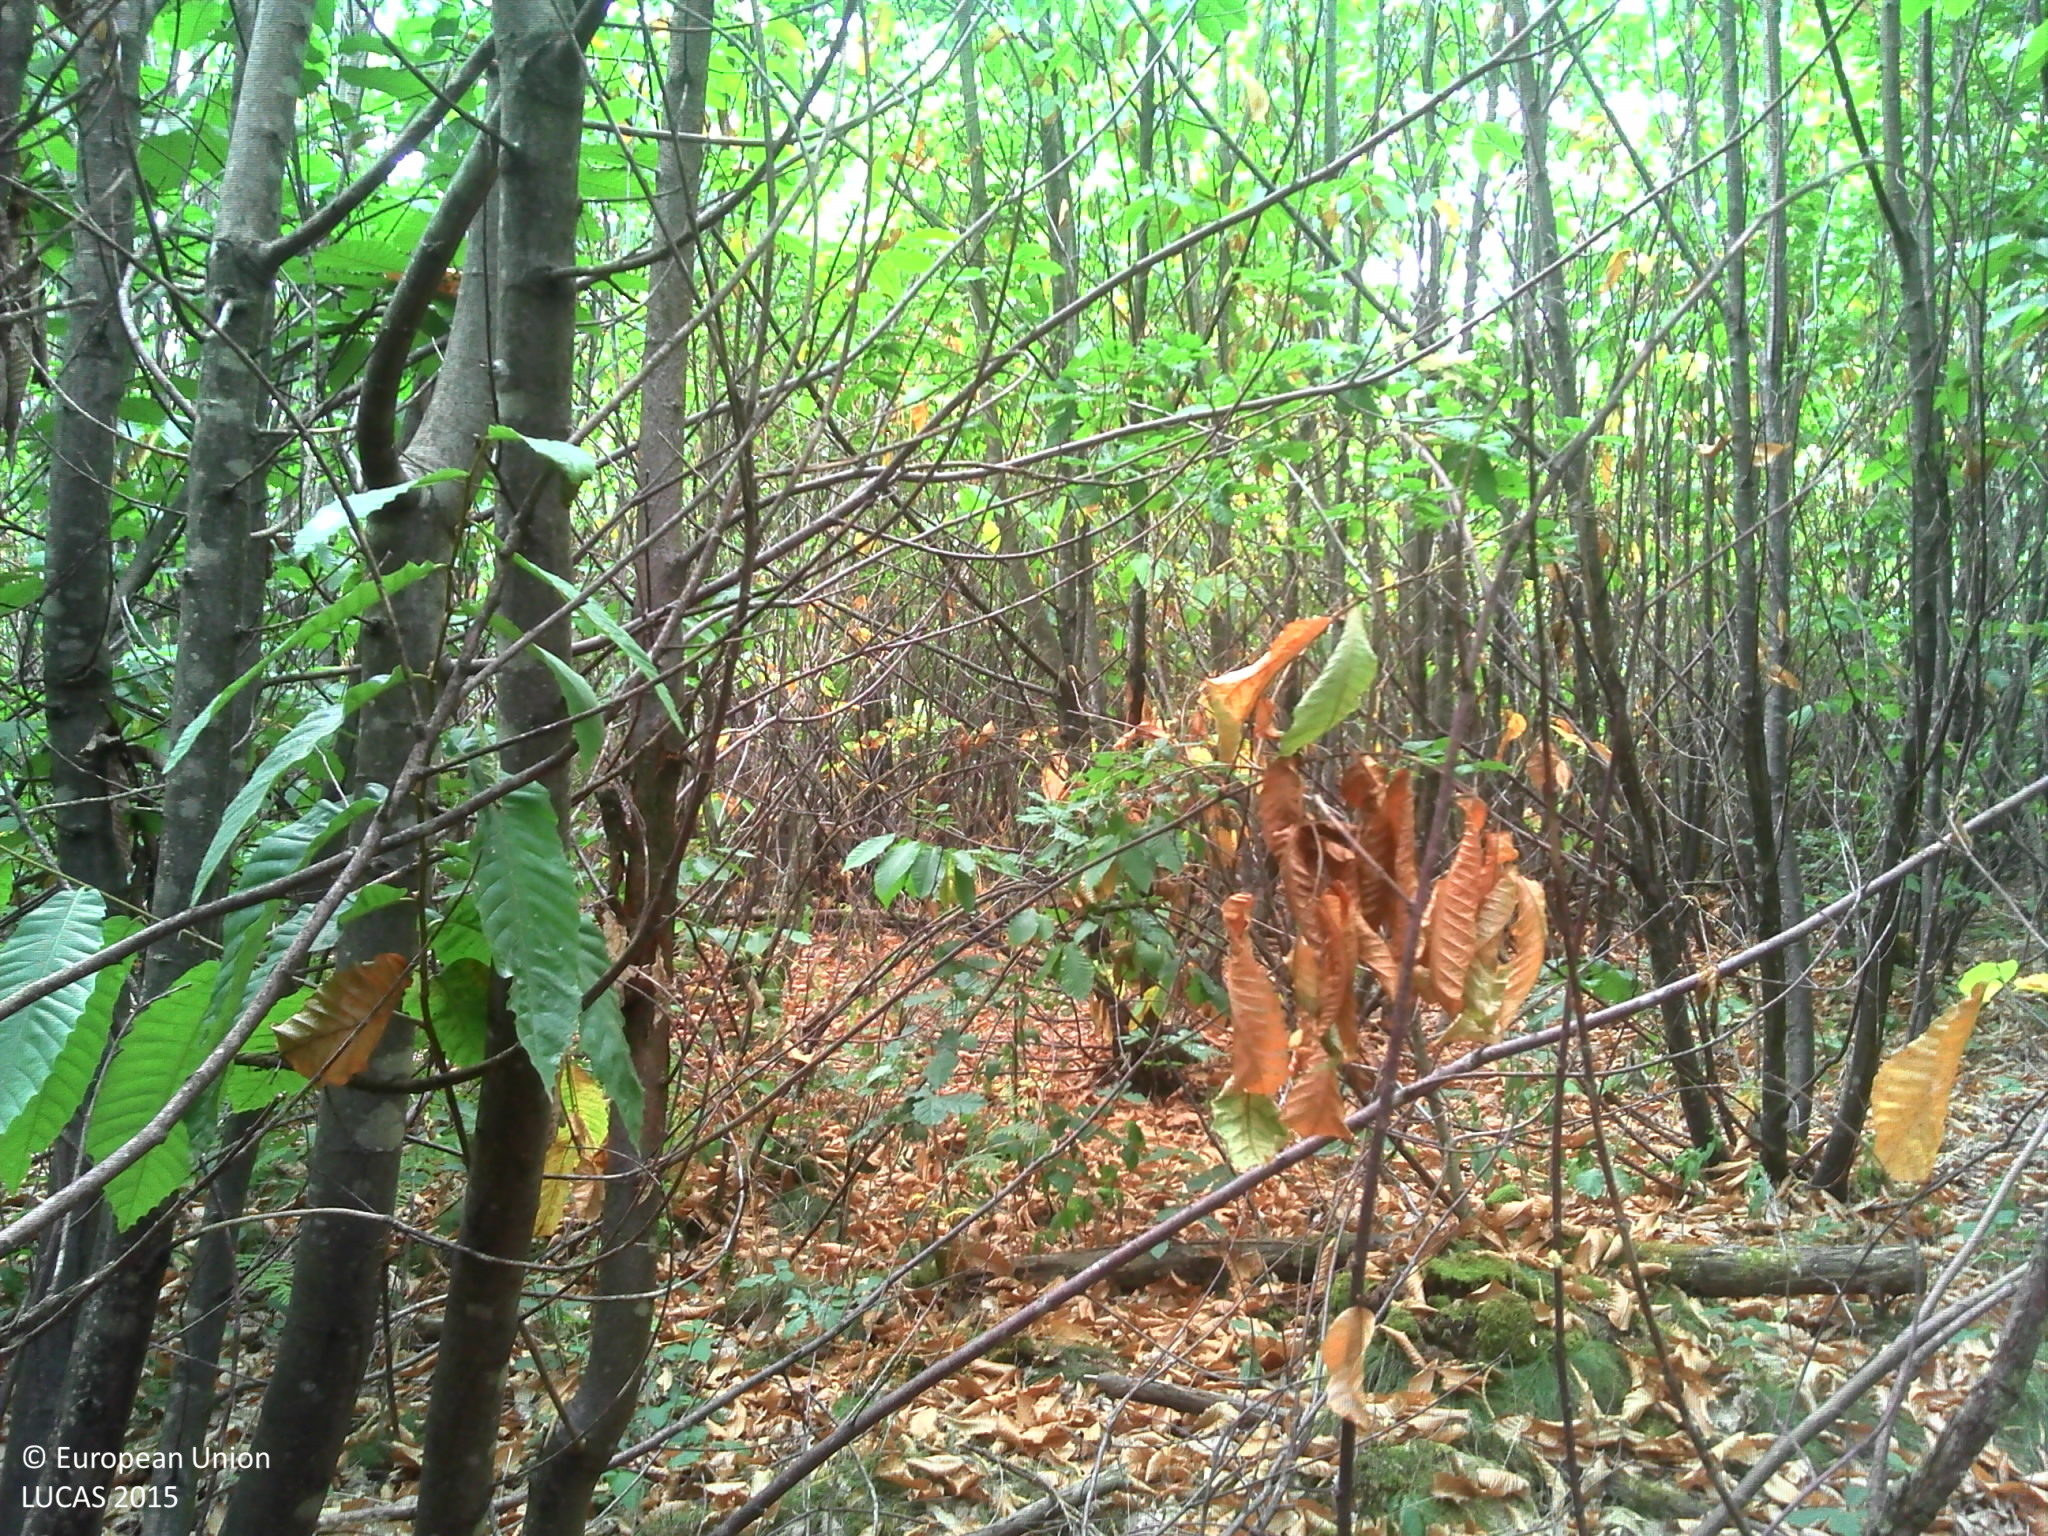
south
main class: Woodland
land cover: Broadleaved woodland
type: acidophilous oak and oak-birch forest
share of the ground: > 75 %
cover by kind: broadleaved forest trees 55 %, lichens and mosses 20 %, herbaceous plants 15 %, unconsolidated bare surface 10 %
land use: Forestry
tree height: > 5 m
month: July
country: FR
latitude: 45.5576
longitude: 1.4741
